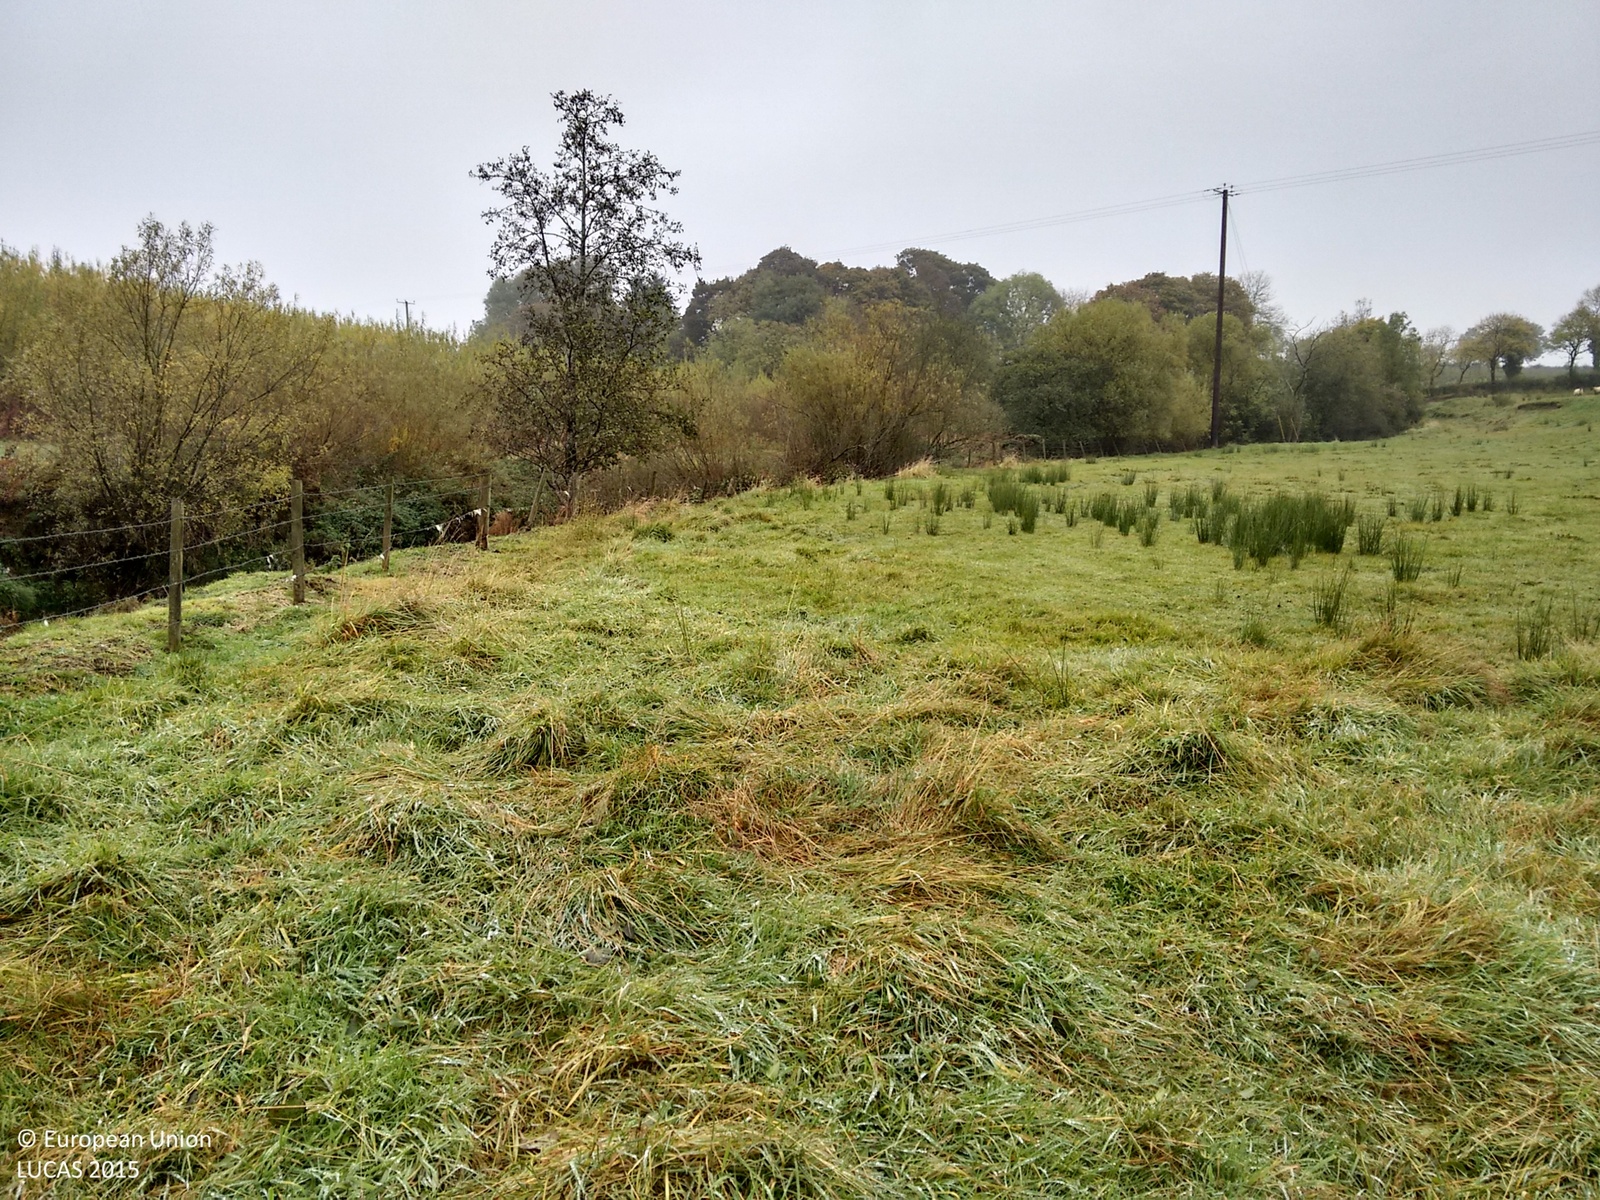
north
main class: Grassland
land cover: Grassland without tree/shrub cover
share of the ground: > 75 %
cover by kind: herbaceous plants 100 %
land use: Agriculture (excluding fallow land and kitchen gardens)
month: October
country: GB
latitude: 54.5351
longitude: -7.4477
